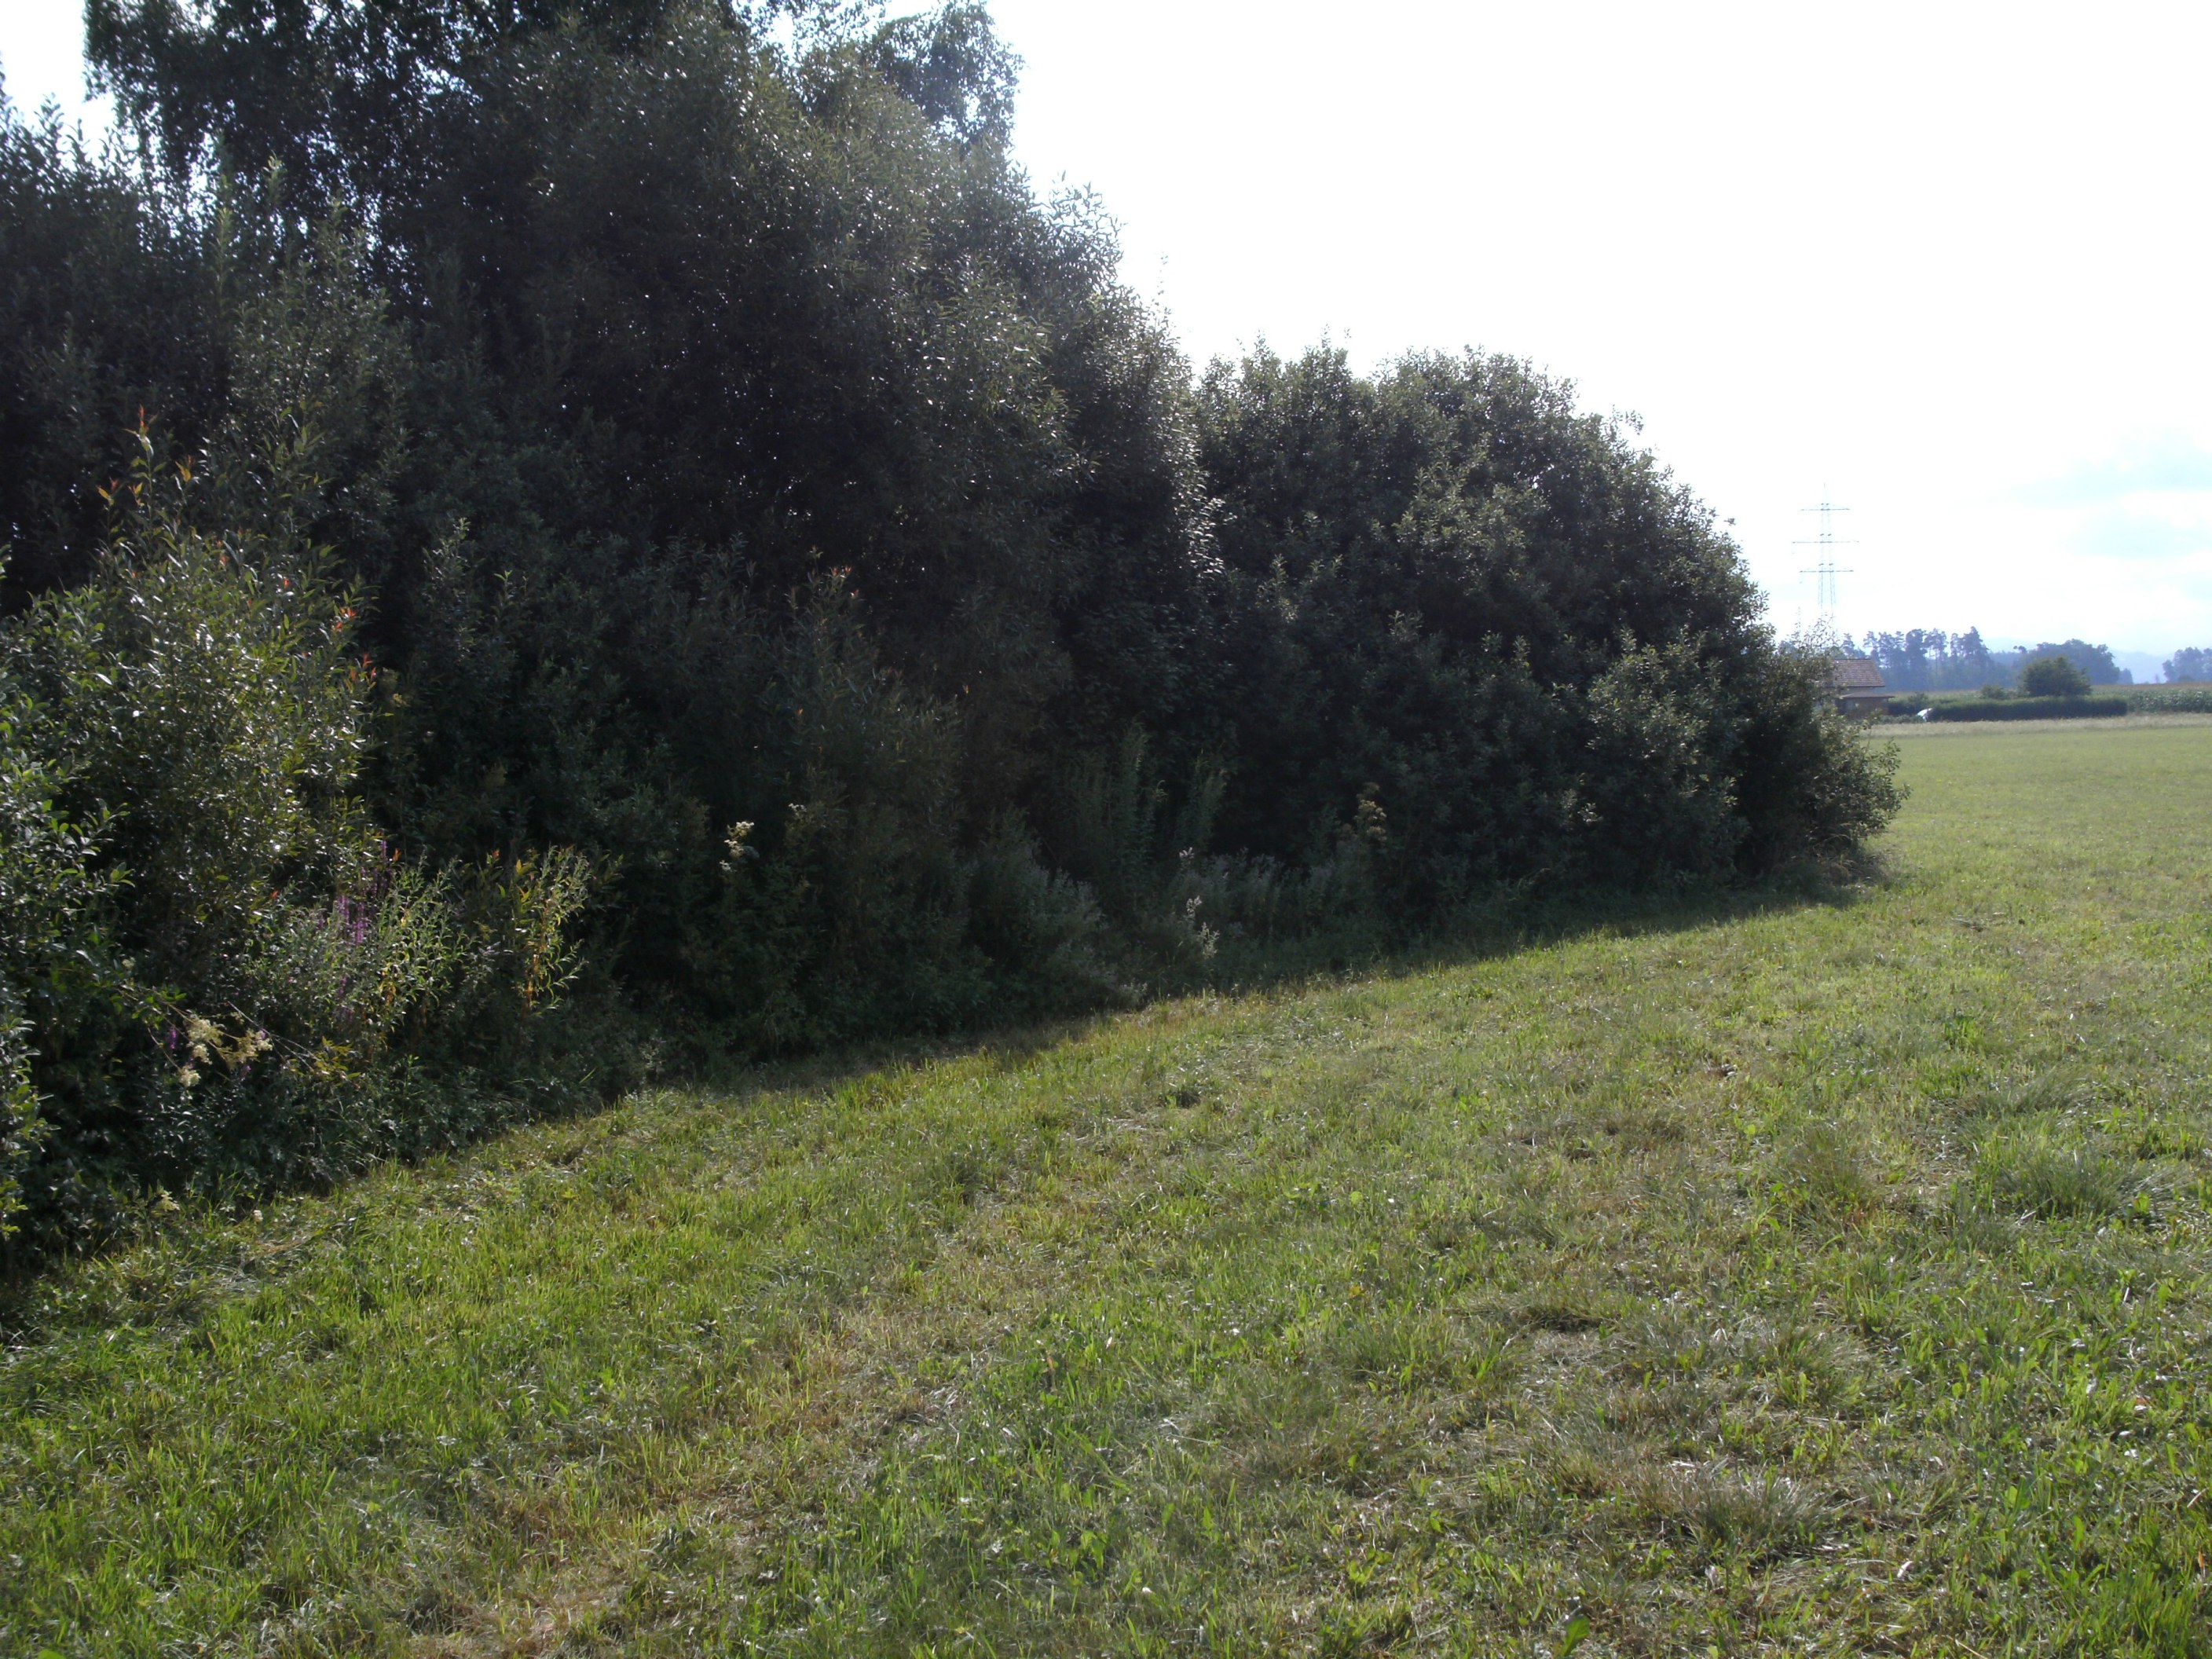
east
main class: Grassland
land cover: Grassland without tree/shrub cover
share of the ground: > 75 %
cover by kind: herbaceous plants 100 %
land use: Agriculture (excluding fallow land and kitchen gardens)
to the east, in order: Grassland without tree/shrub cover; Shrubland without tree cover; Rivers and streams; Shrubland without tree cover; Rivers and streams; Shrubland without tree cover; Grassland without tree/shrub cover; Rivers and streams; Broadleaved woodland; Grassland without tree/shrub cover; Broadleaved woodland; Grassland without tree/shrub cover; Single bushes/trees; Grassland without tree/shrub cover; Shrubland with sparse tree cover; Rivers and streams; Grass margins; Artificial constructions in urban areas
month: July
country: AT
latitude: 46.5700
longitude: 14.7599
